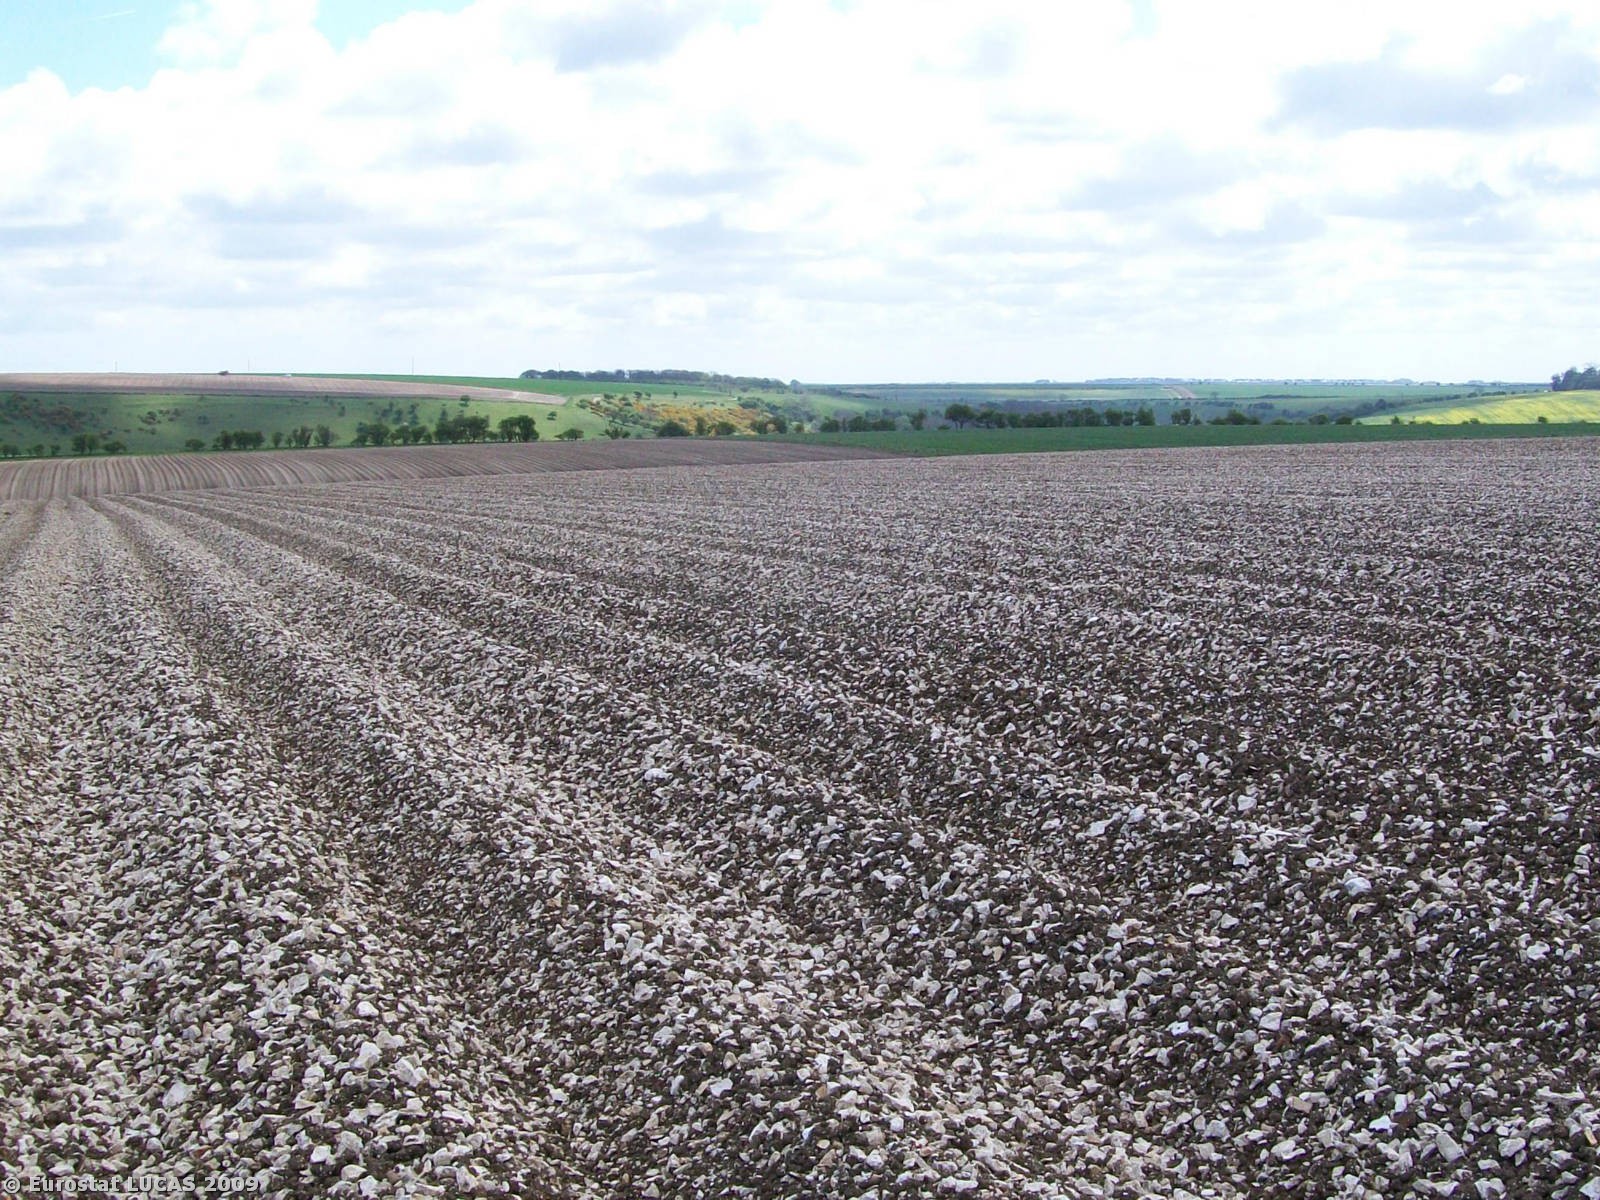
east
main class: Cropland
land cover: Potatoes
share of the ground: < 10 %
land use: Agriculture (excluding fallow land and kitchen gardens)
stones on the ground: > 50 %
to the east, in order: Potatoes
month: May
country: GB
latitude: 54.1852
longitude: -0.4094
